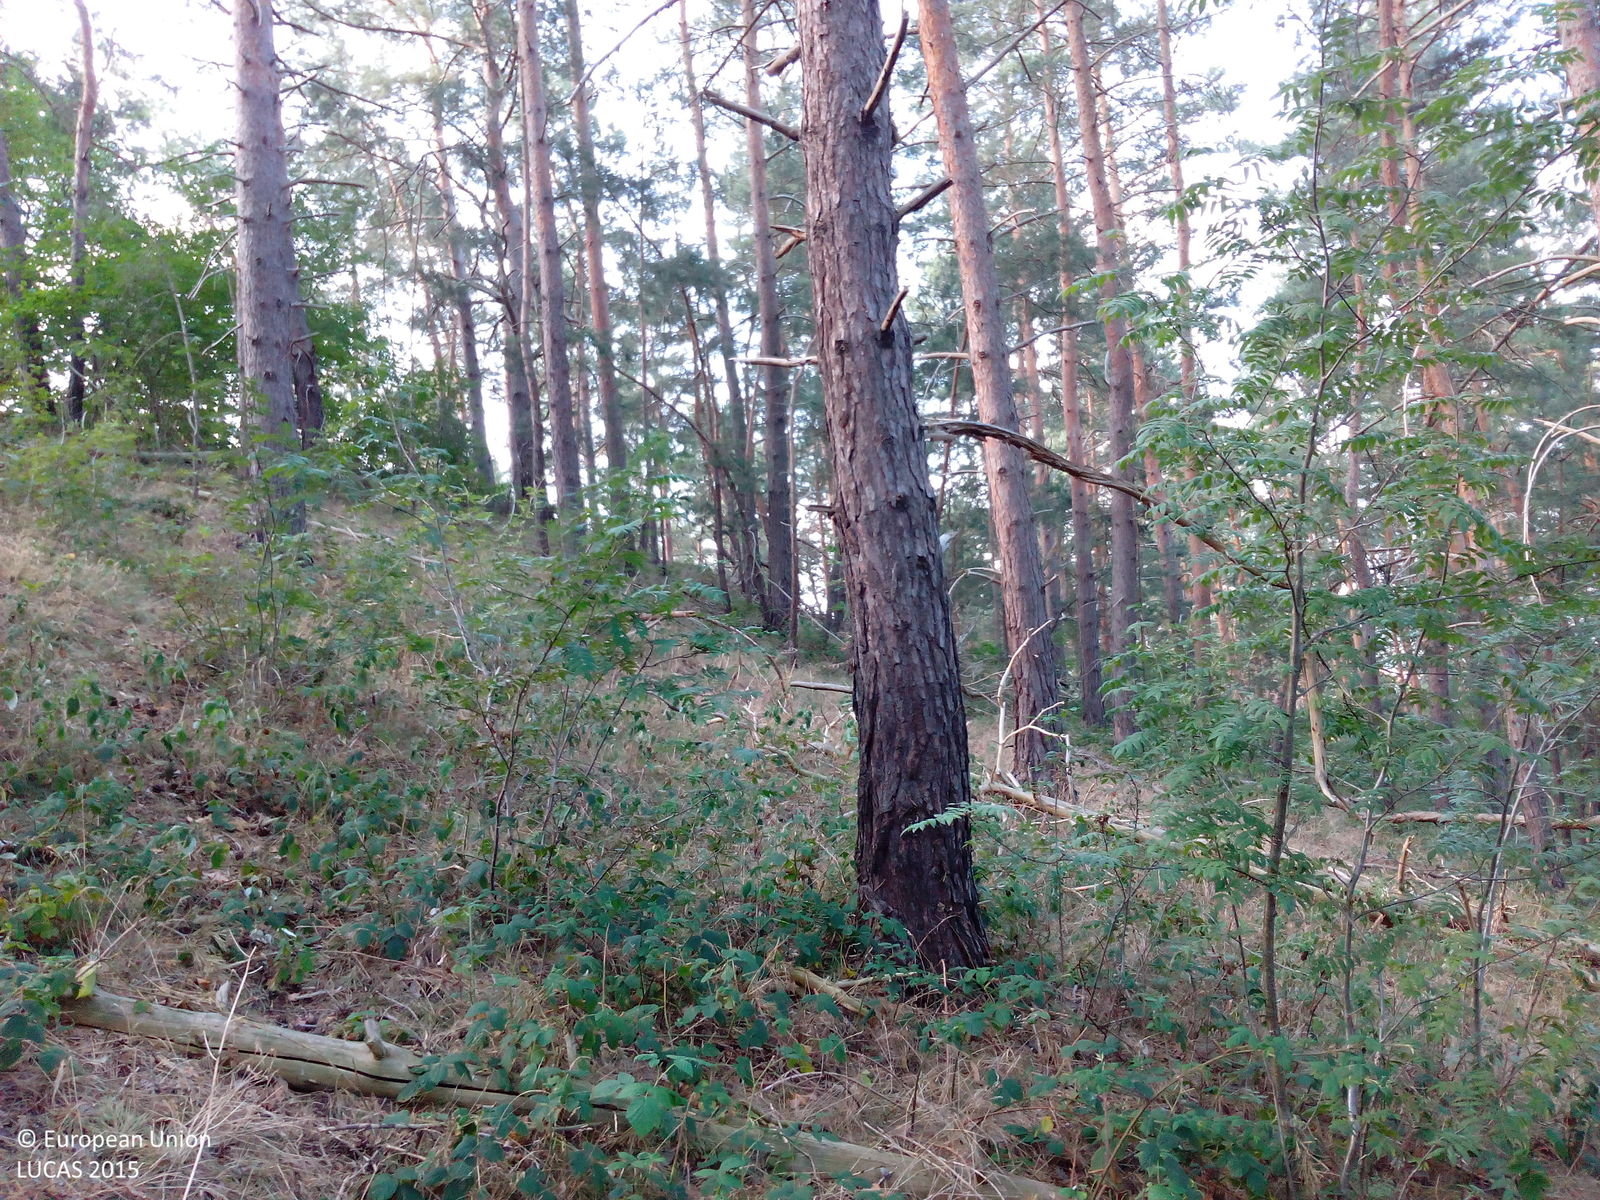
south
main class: Woodland
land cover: Pine dominated coniferous woodland
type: hemiboreal forest and nemoral coniferous forest and mixed broadleaved-coniferous forest
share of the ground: > 75 %
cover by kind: coniferous forest trees 90 %, herbaceous plants 10 %
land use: Forestry
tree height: > 5 m
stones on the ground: < 10 %
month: August
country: DE
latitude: 51.8165
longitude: 10.9426
